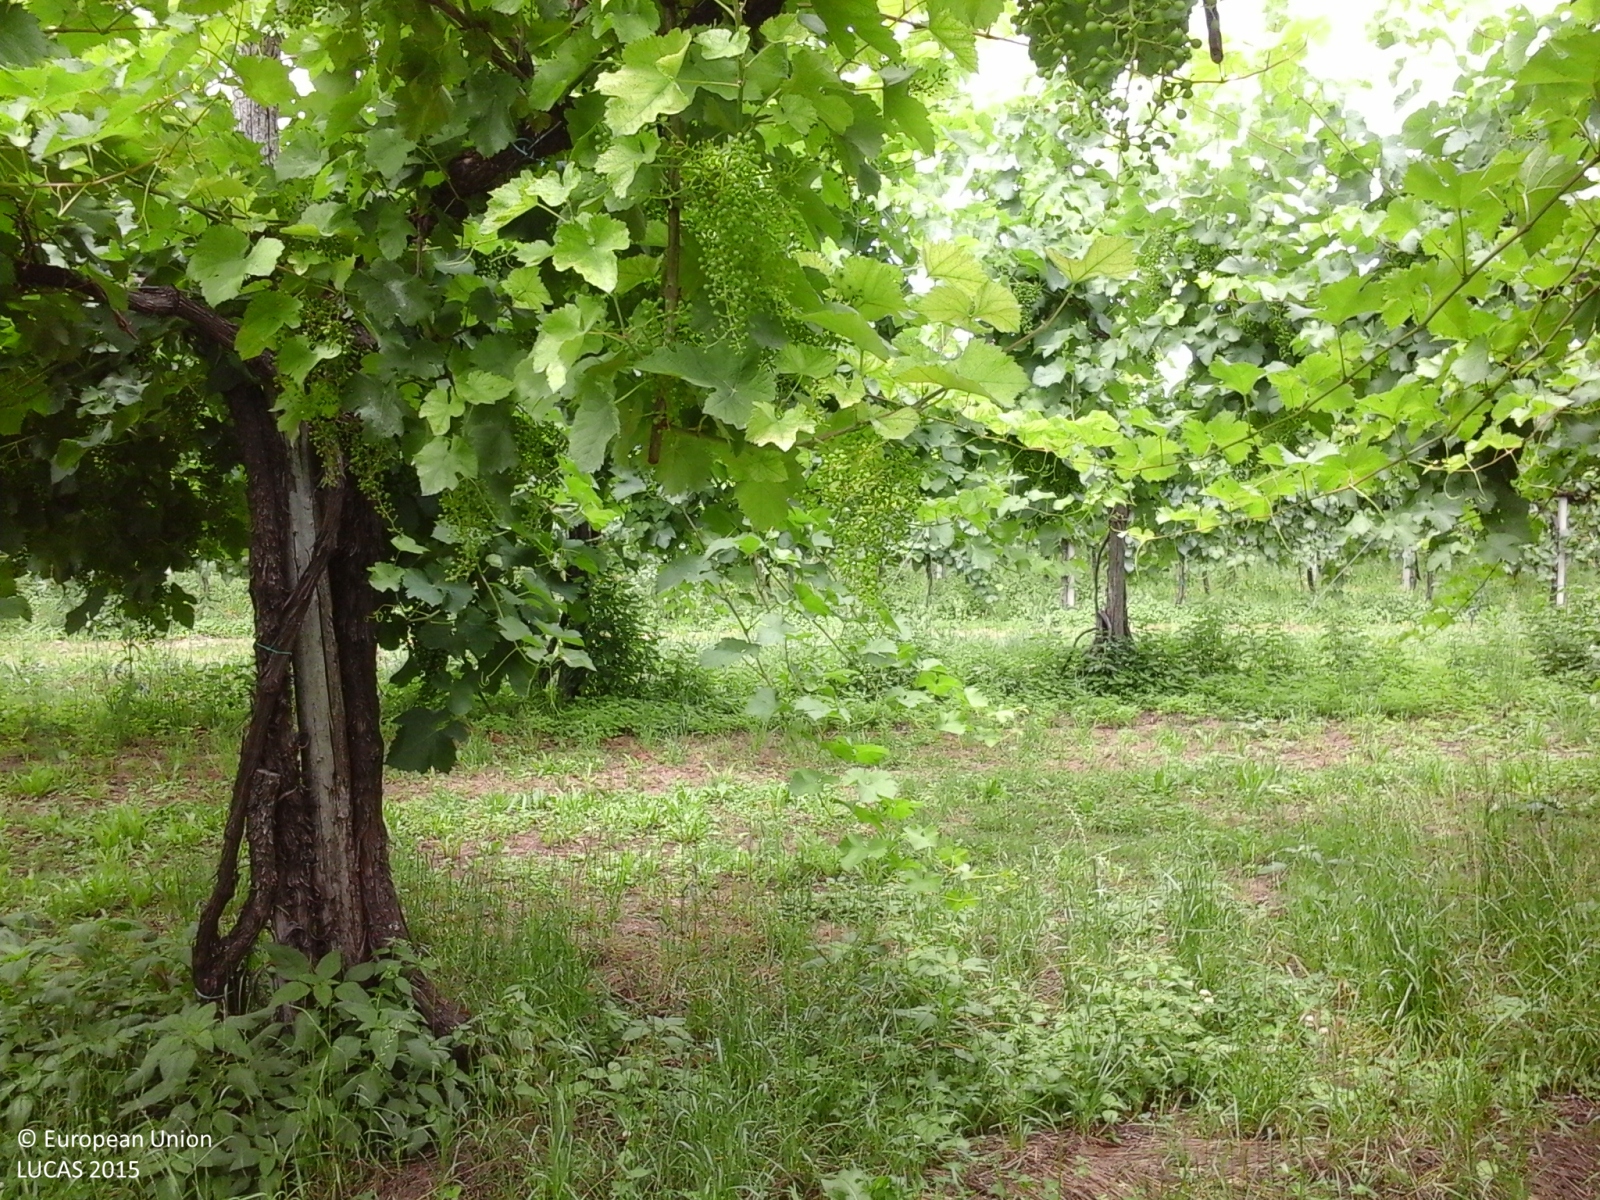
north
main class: Cropland
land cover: Vineyards
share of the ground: > 75 %
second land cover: Grassland without tree/shrub cover
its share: > 75 %
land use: Agriculture (excluding fallow land and kitchen gardens)
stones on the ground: < 10 %
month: June
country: IT
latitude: 45.7290
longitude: 12.4252
